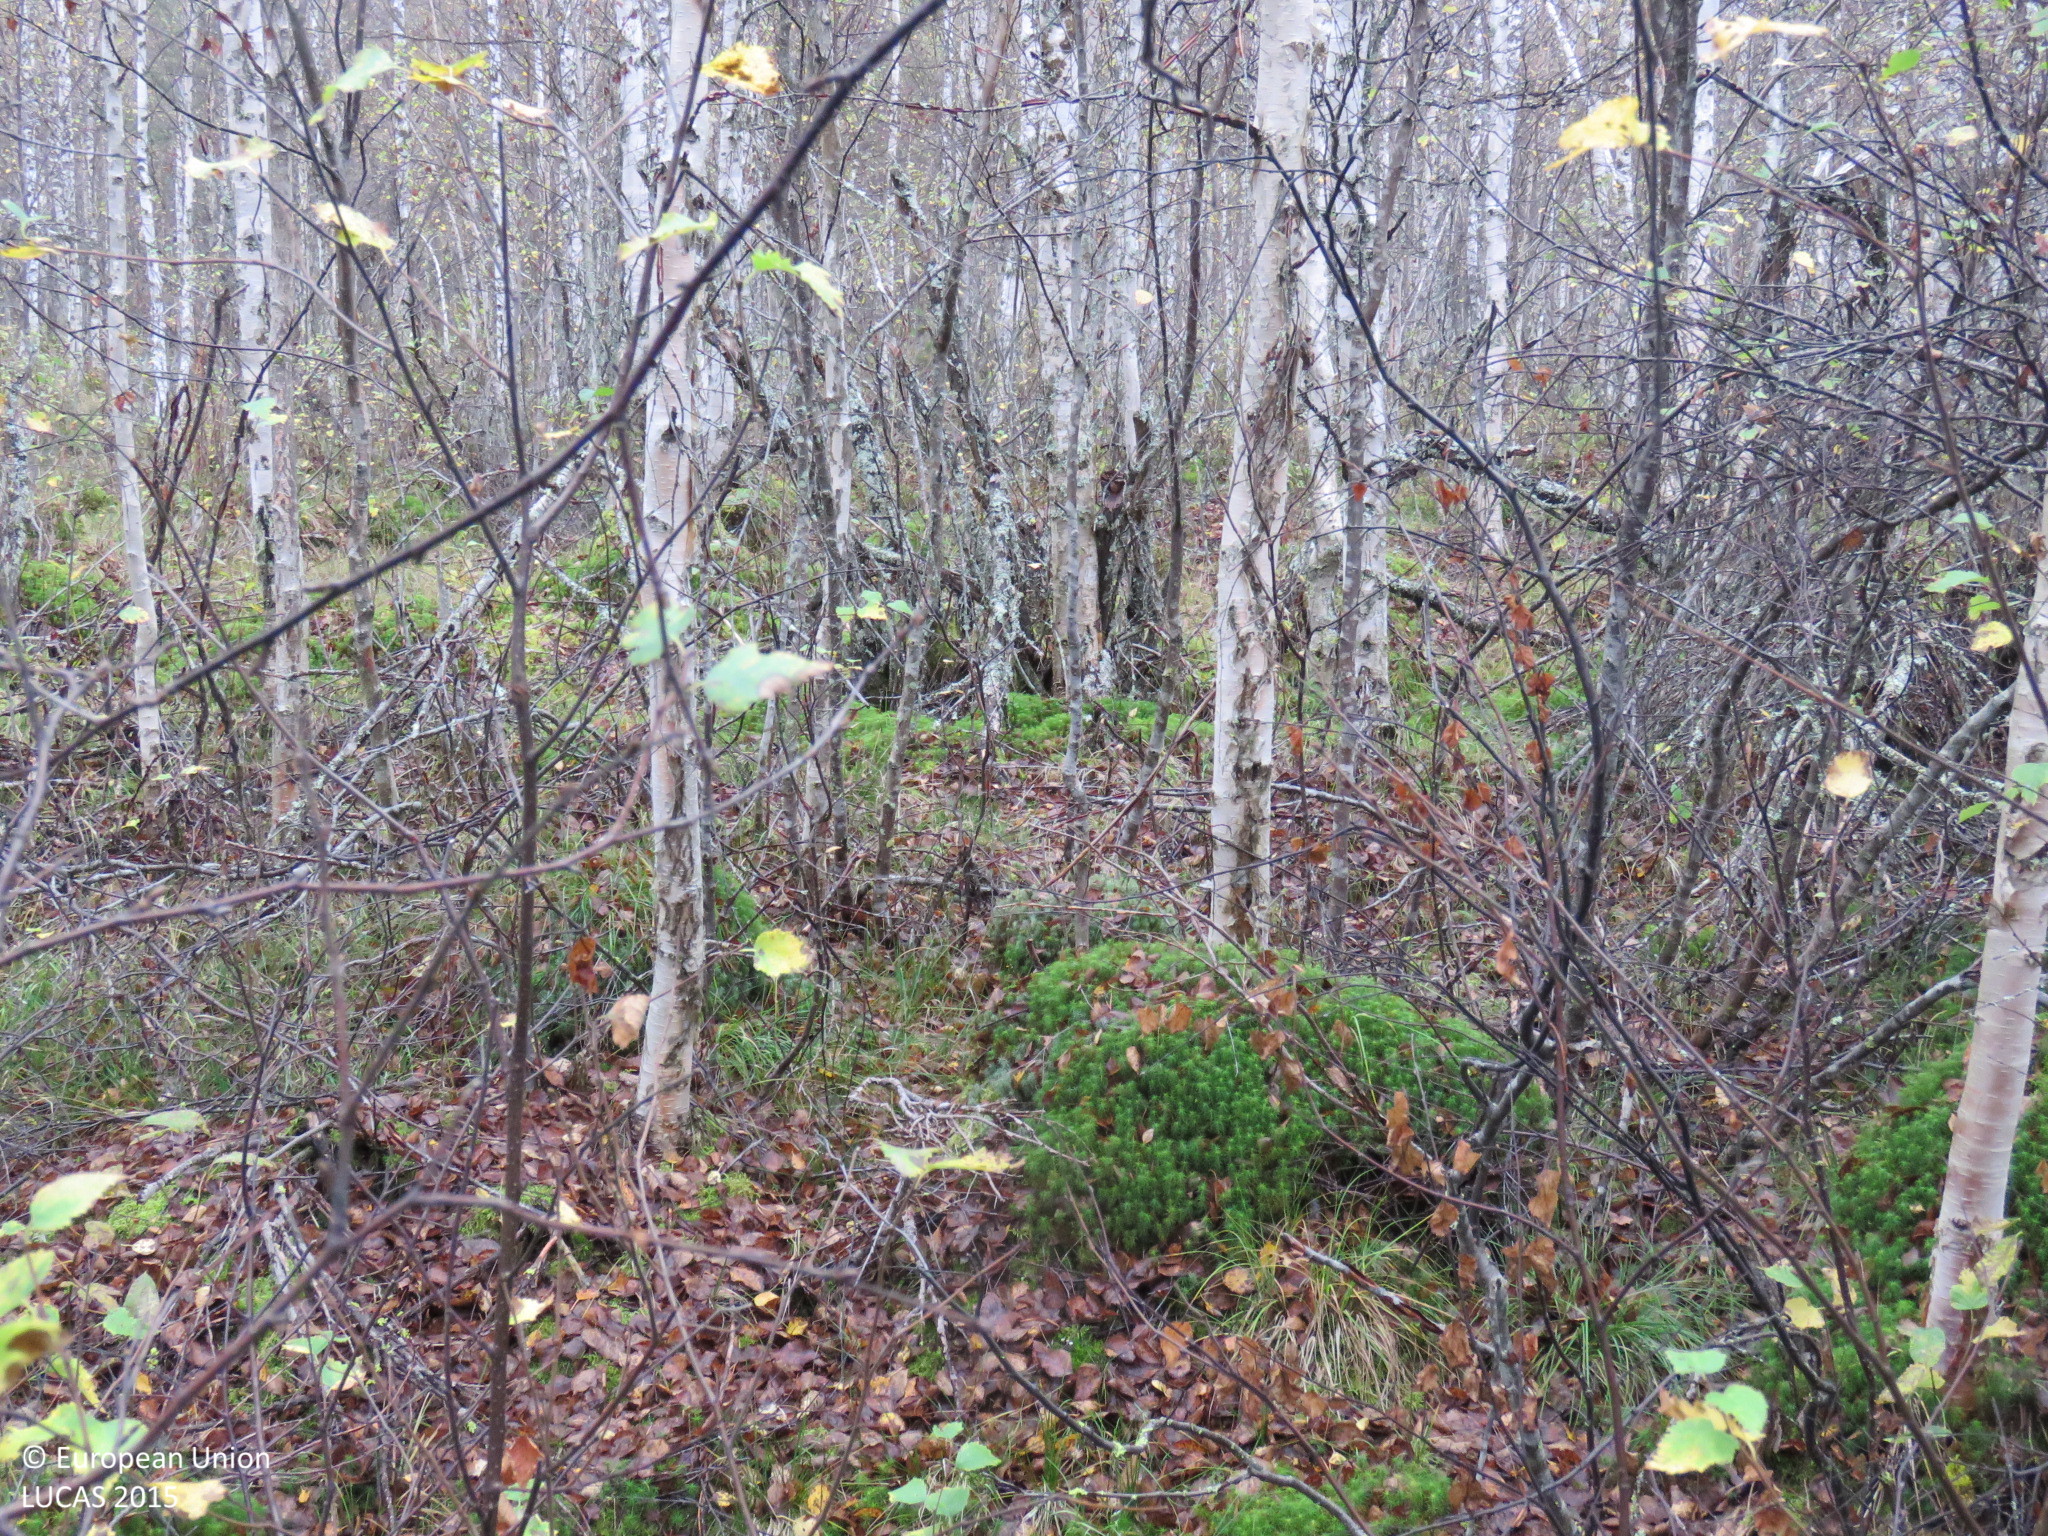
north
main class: Woodland
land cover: Broadleaved woodland
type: mire and swamp forests
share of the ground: > 75 %
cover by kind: broadleaved forest trees 70 %, coniferous forest trees 10 %, herbaceous plants 10 %, lichens and mosses 10 %
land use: Forestry
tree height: > 5 m
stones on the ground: < 10 %
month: September
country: FI
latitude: 65.1924
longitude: 26.8837
